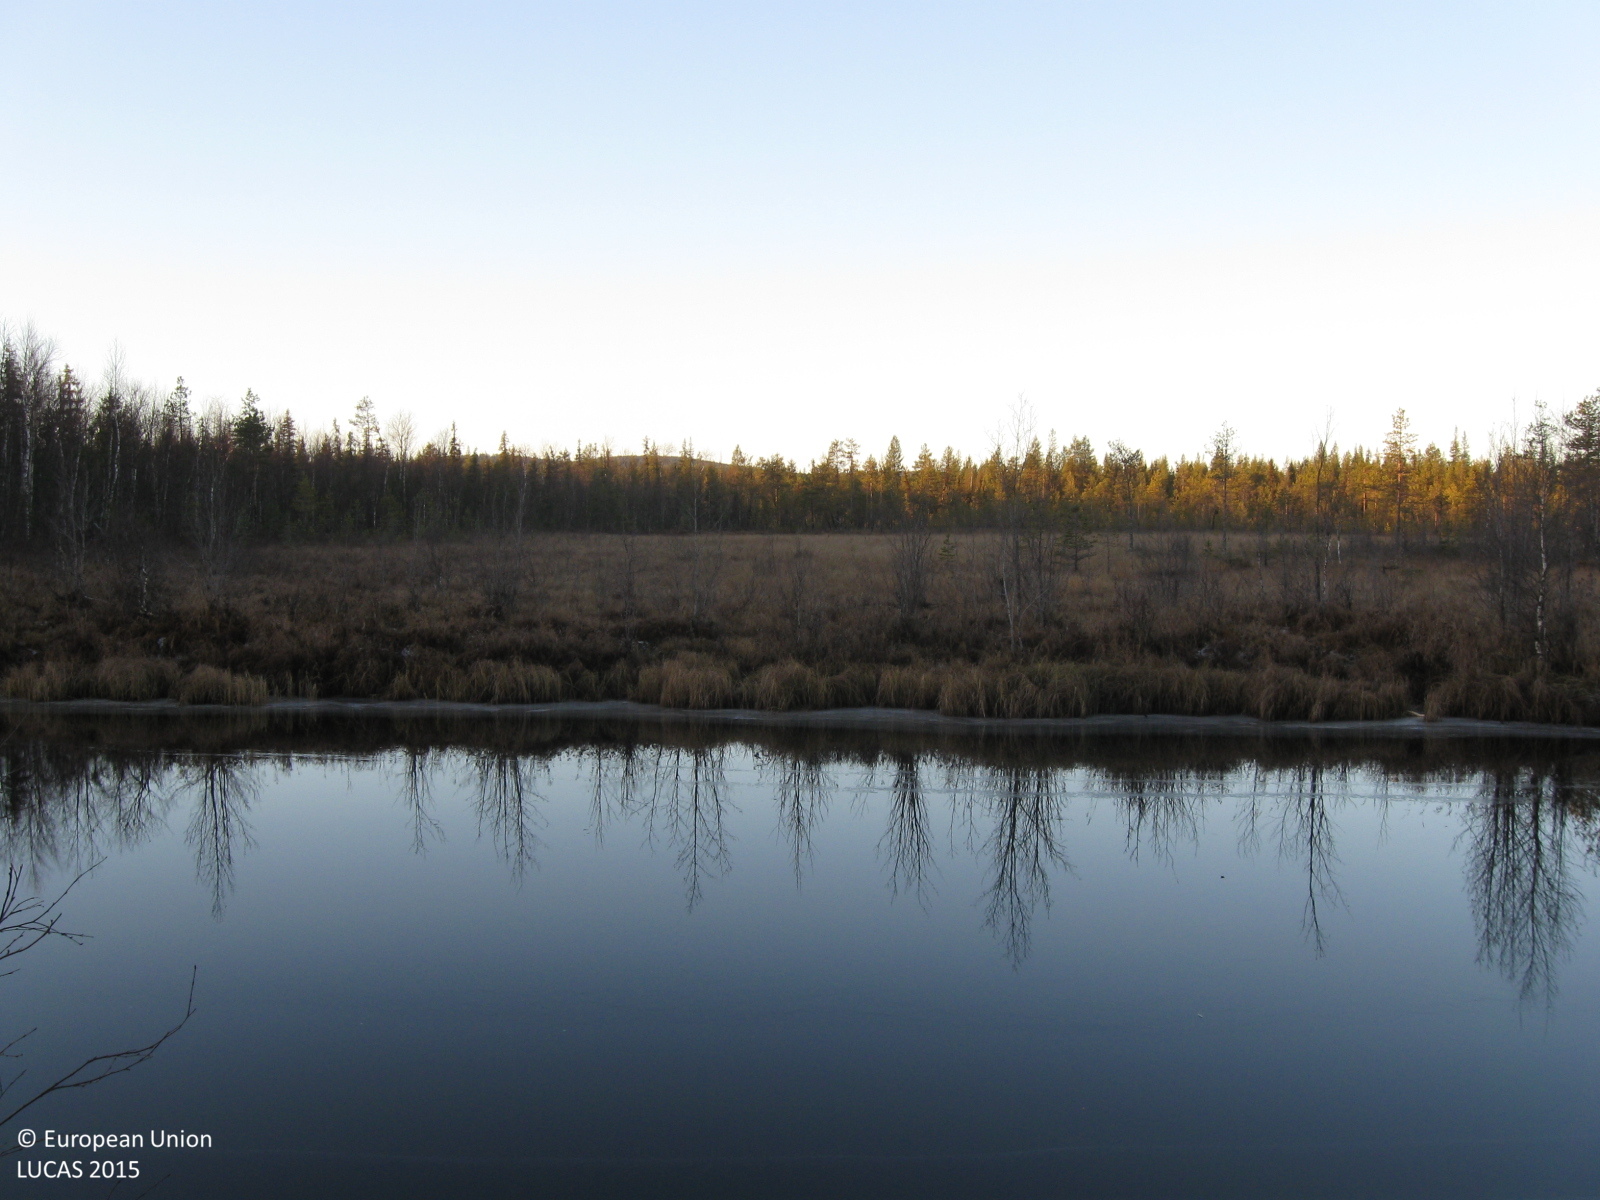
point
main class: Grassland
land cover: Grassland with sparse tree/shrub cover
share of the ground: > 75 %
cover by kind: herbaceous plants 90 %, broadleaved forest trees 5 %, shrubs 5 %
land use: Semi-natural and natural areas not in use
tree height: < 5 m
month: November
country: SE
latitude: 66.2136
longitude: 20.6476
